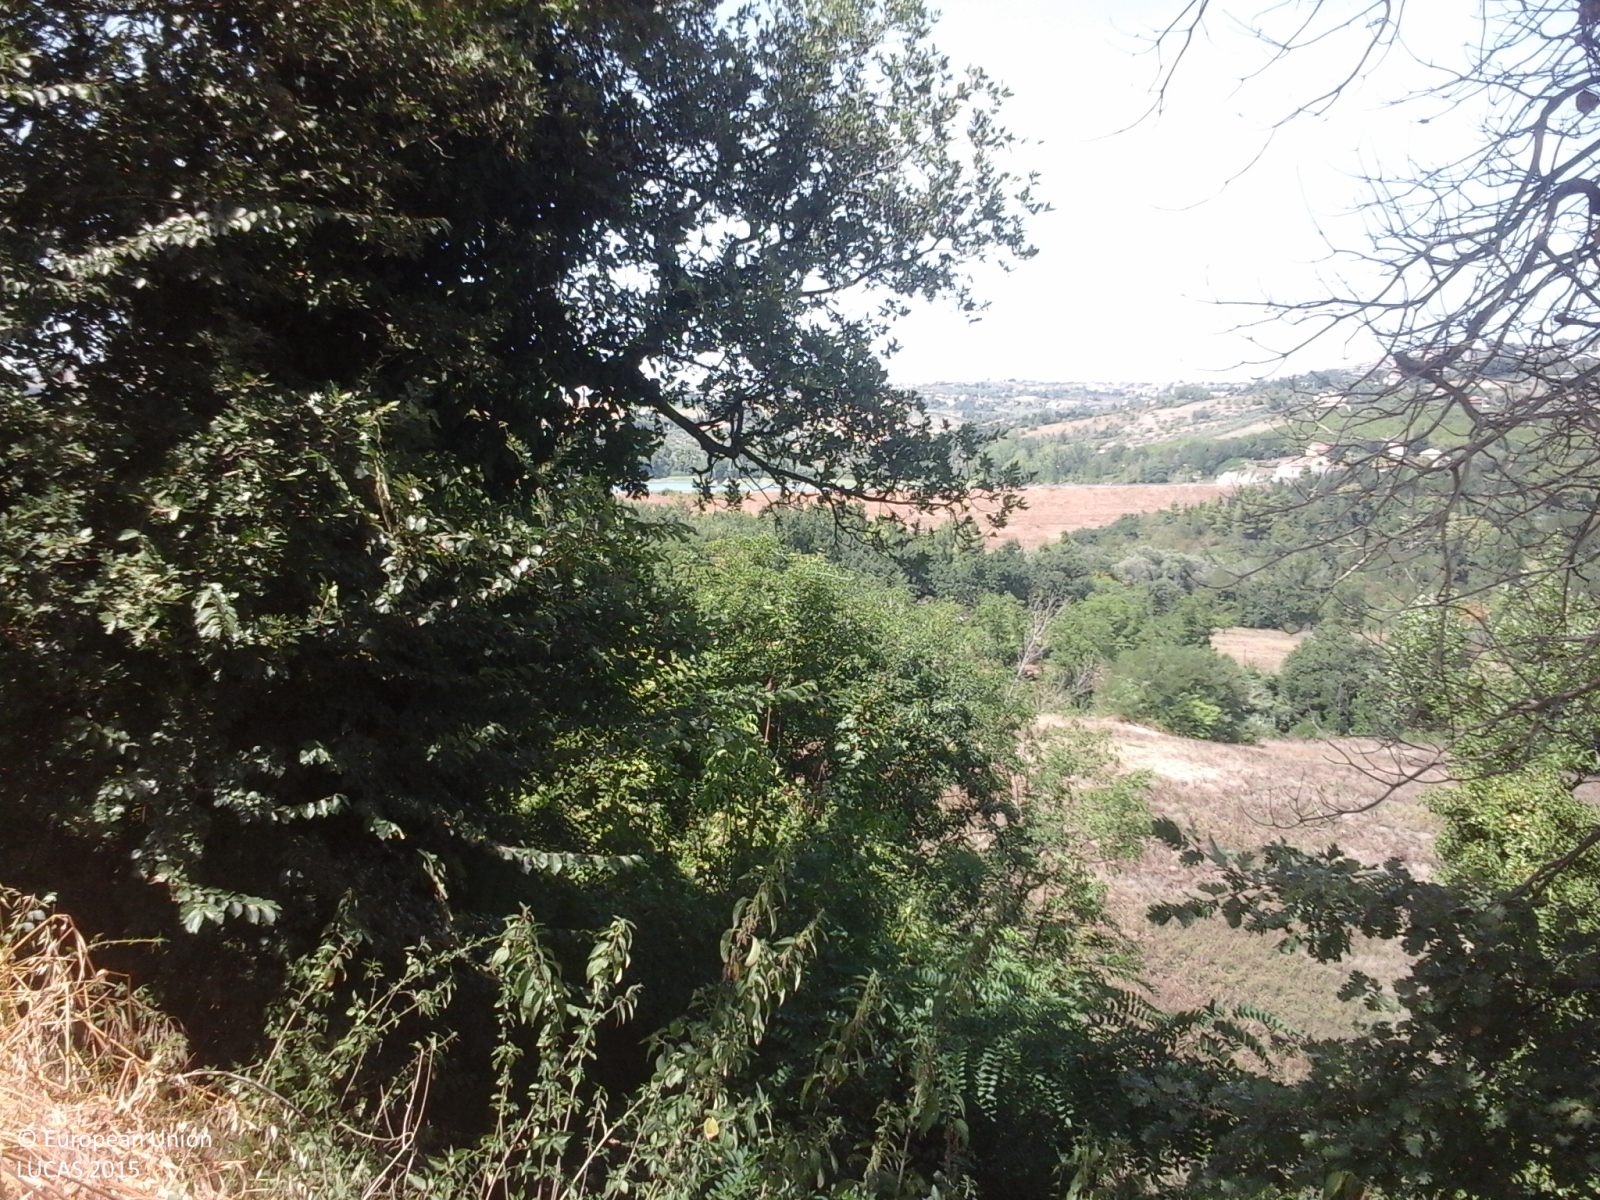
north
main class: Woodland
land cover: Broadleaved woodland
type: thermophilous deciduous forest
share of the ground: > 75 %
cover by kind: broadleaved forest trees 80 %, shrubs 10 %, herbaceous plants 10 %
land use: Semi-natural and natural areas not in use
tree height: > 5 m
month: August
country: IT
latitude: 42.4337
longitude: 13.9144
